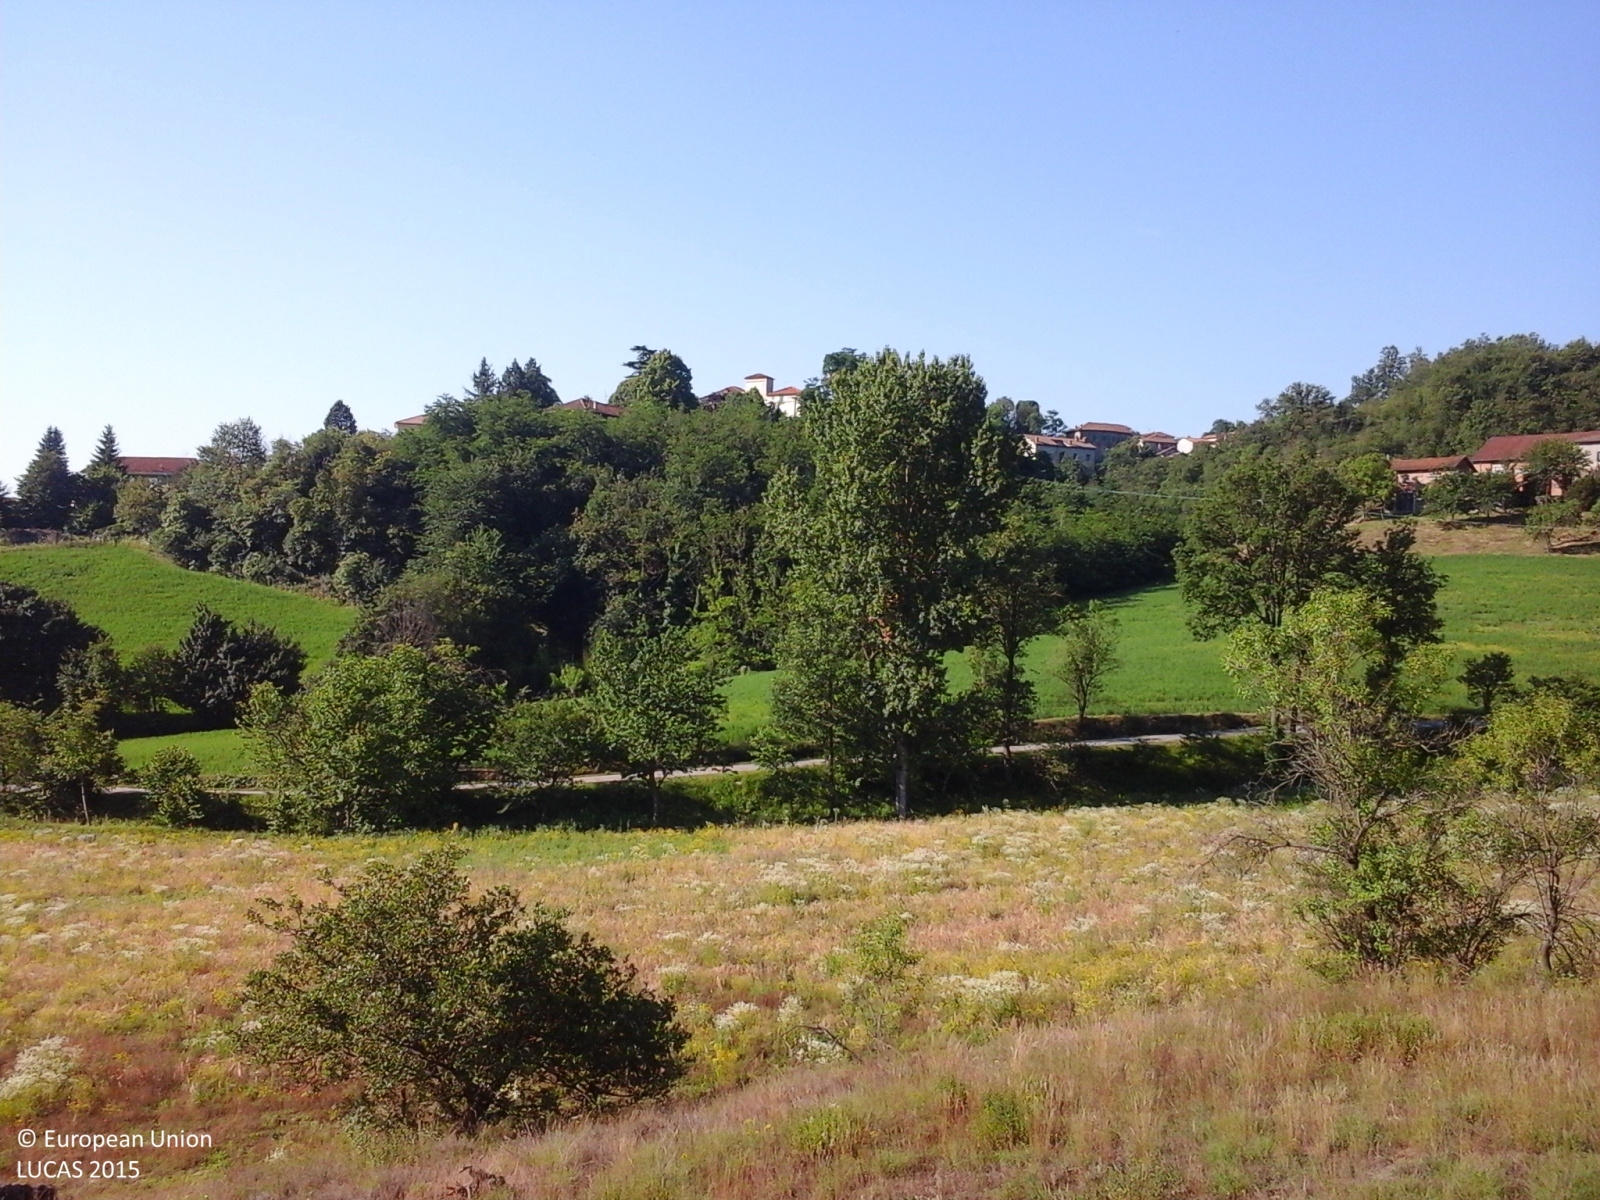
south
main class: Shrubland
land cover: Shrubland with sparse tree cover
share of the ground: > 75 %
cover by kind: herbaceous plants 50 %, consolidated bare surface 25 %, shrubs 20 %, broadleaved forest trees 5 %
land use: Semi-natural and natural areas not in use
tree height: < 5 m
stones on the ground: > 50 %
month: June
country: IT
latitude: 44.5716
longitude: 8.3287
